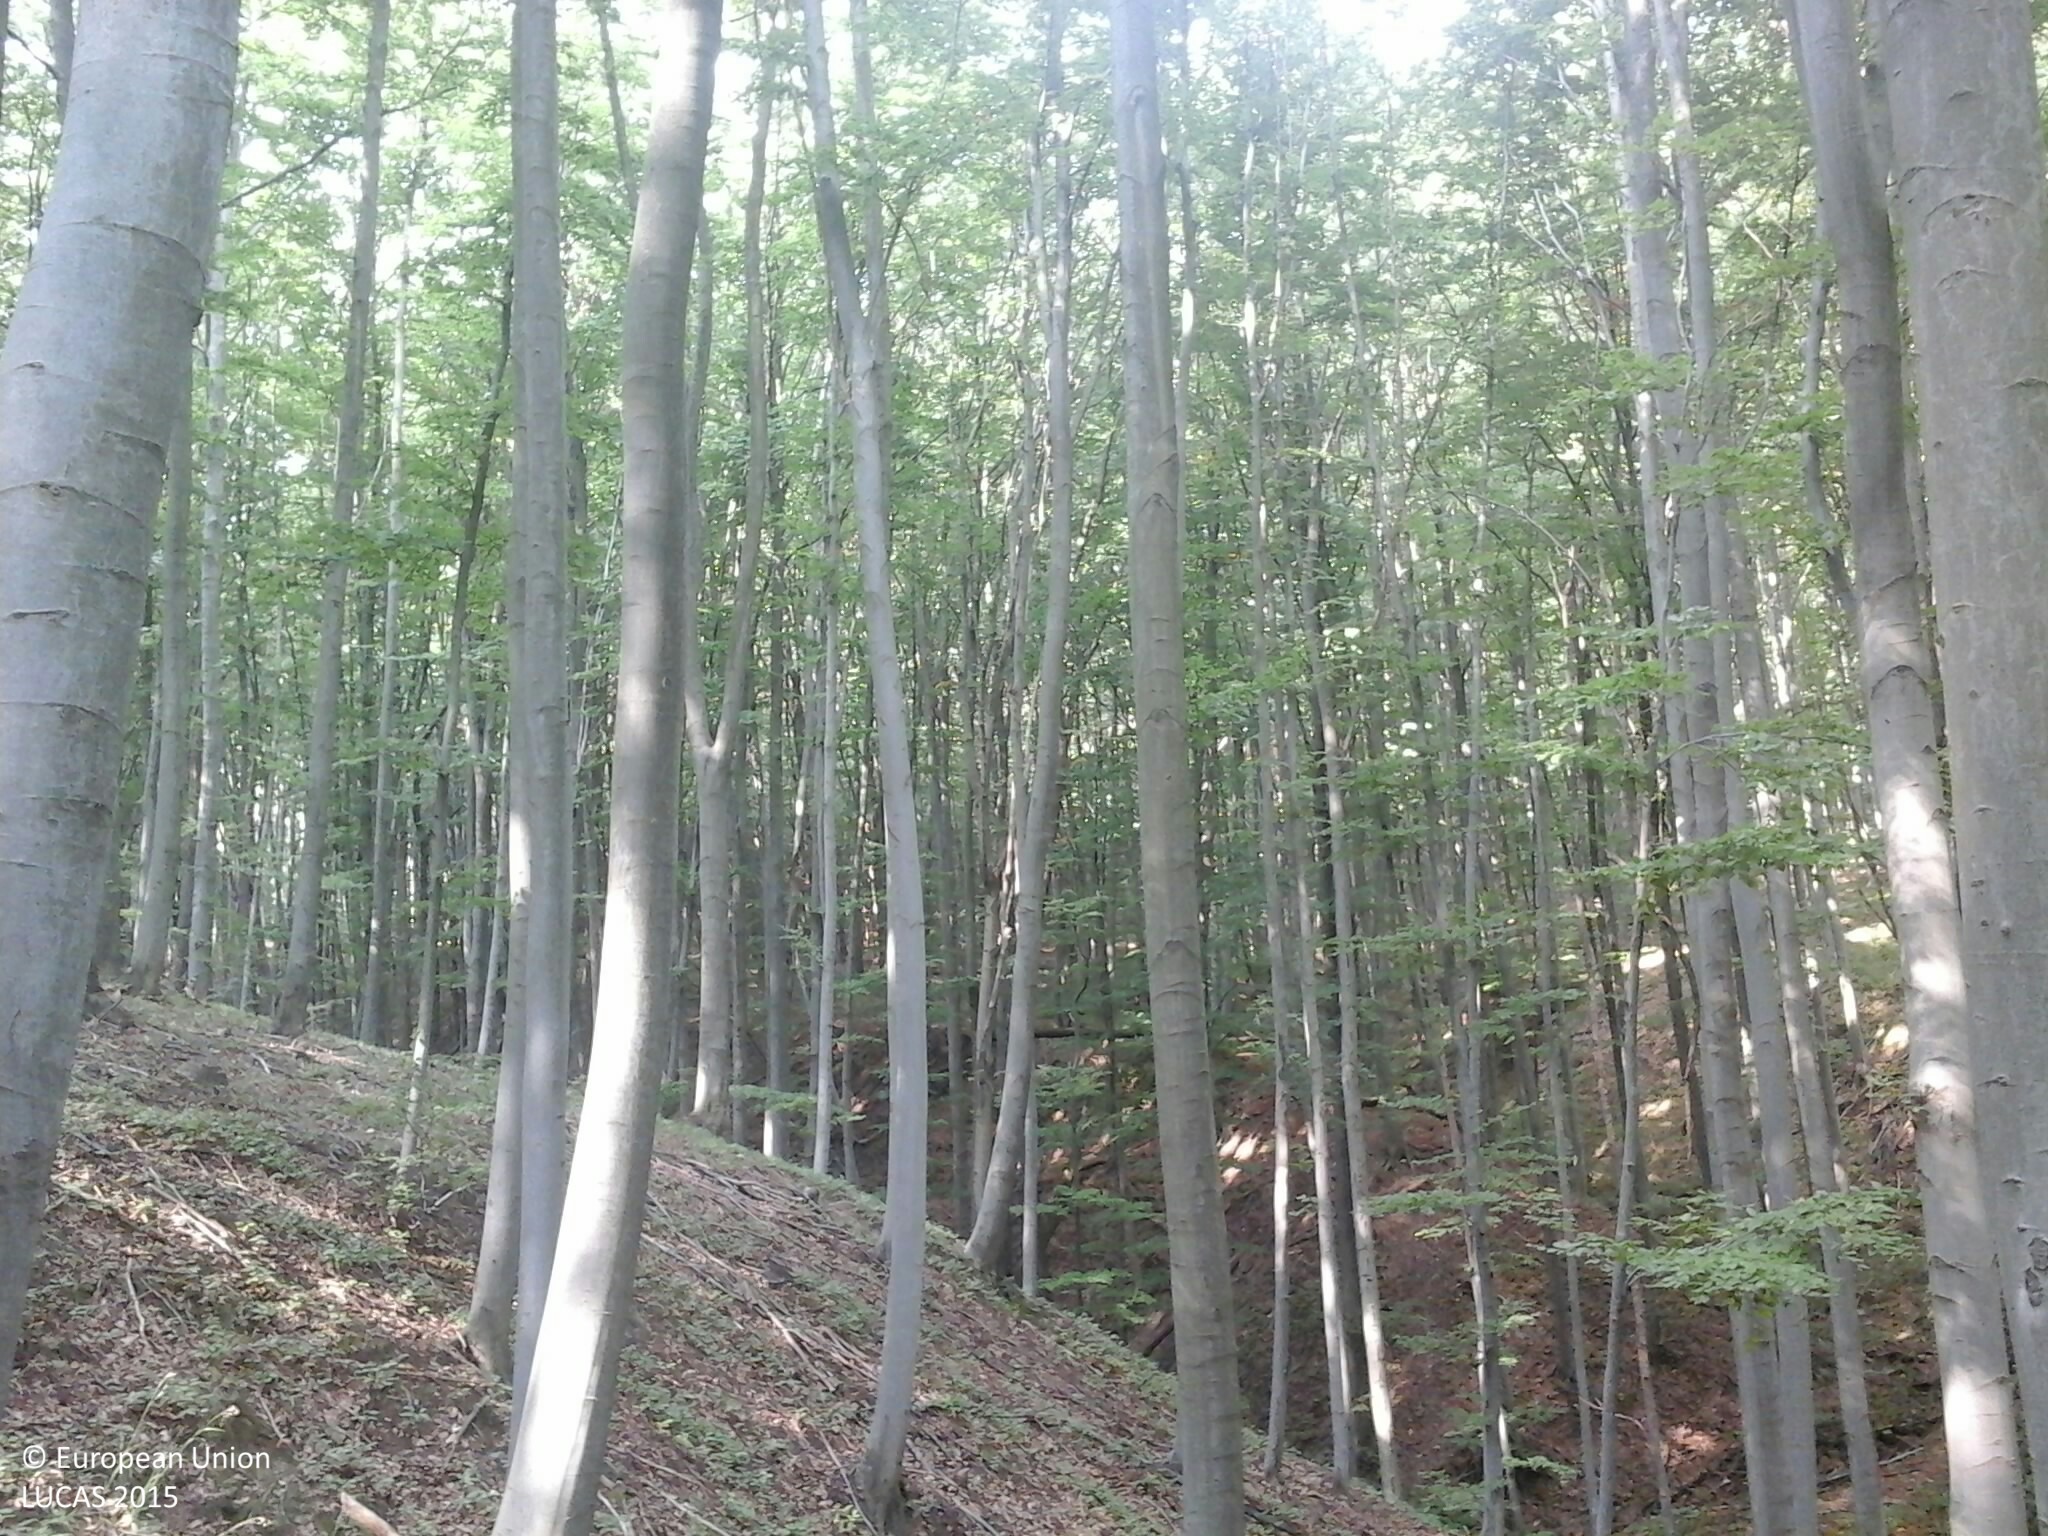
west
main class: Woodland
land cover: Broadleaved woodland
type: beech forest
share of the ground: > 75 %
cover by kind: broadleaved forest trees 95 %, herbaceous plants 5 %
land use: Forestry
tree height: > 5 m
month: September
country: HU
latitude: 47.9156
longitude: 19.9693
